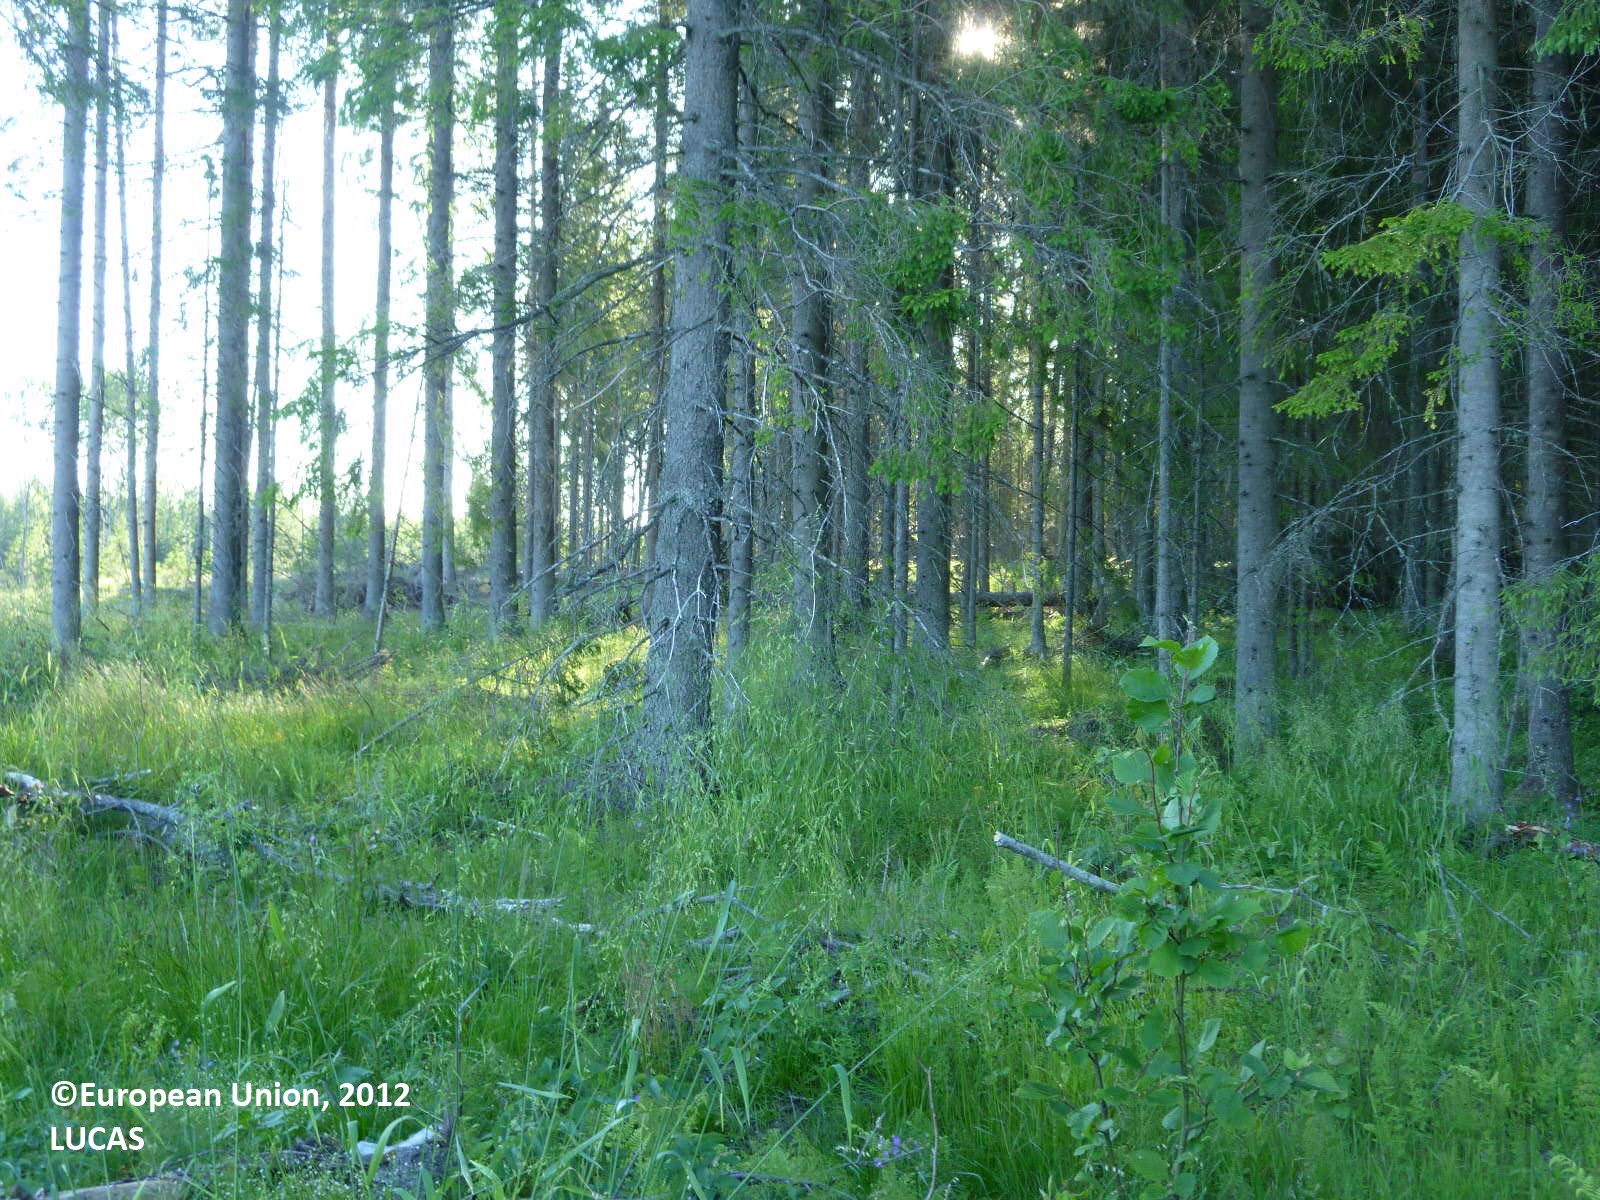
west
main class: Grassland
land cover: Grassland without tree/shrub cover
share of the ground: 25 - 50 %
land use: Forestry
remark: Clear cut
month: June
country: FI
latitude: 61.6666
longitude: 22.0880
